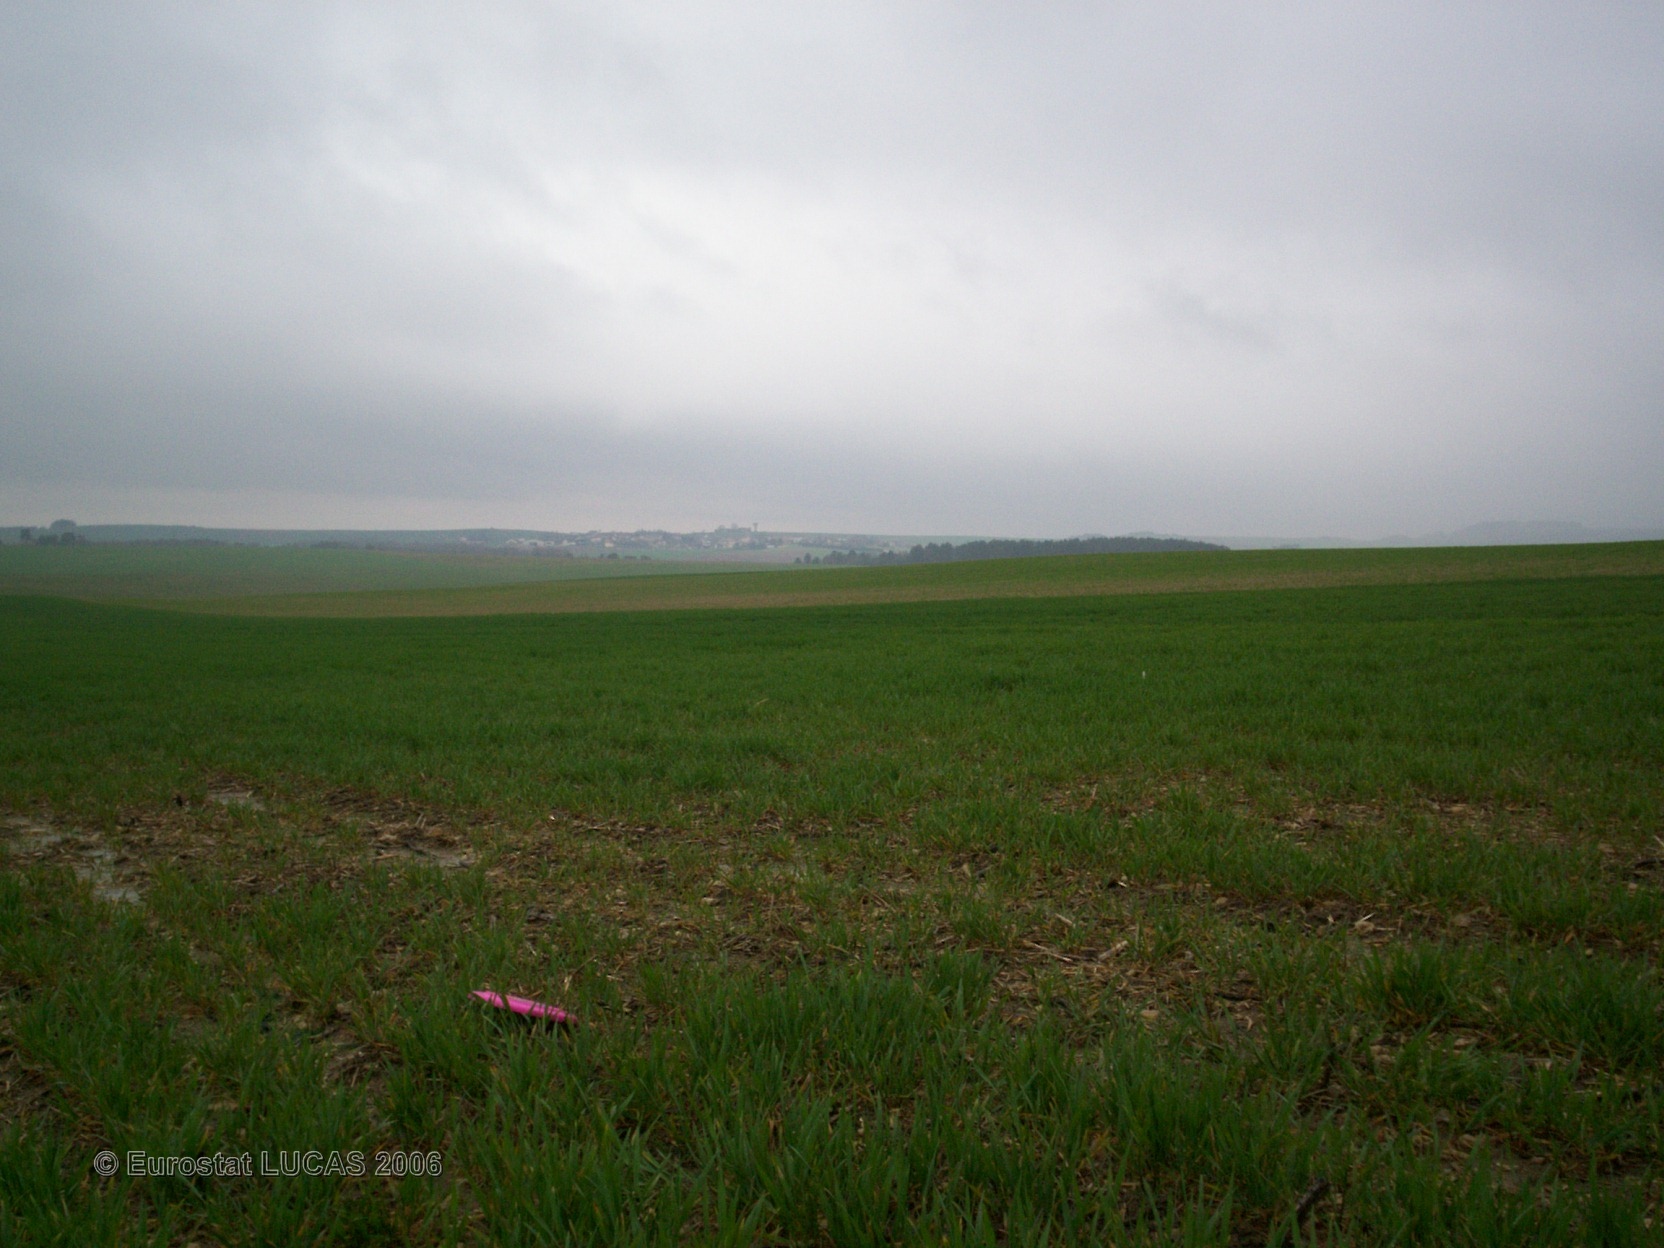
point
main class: Cropland
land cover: Barley
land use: Agriculture (excluding fallow land and kitchen gardens)
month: April
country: FR
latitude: 48.0932
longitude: 4.6410
